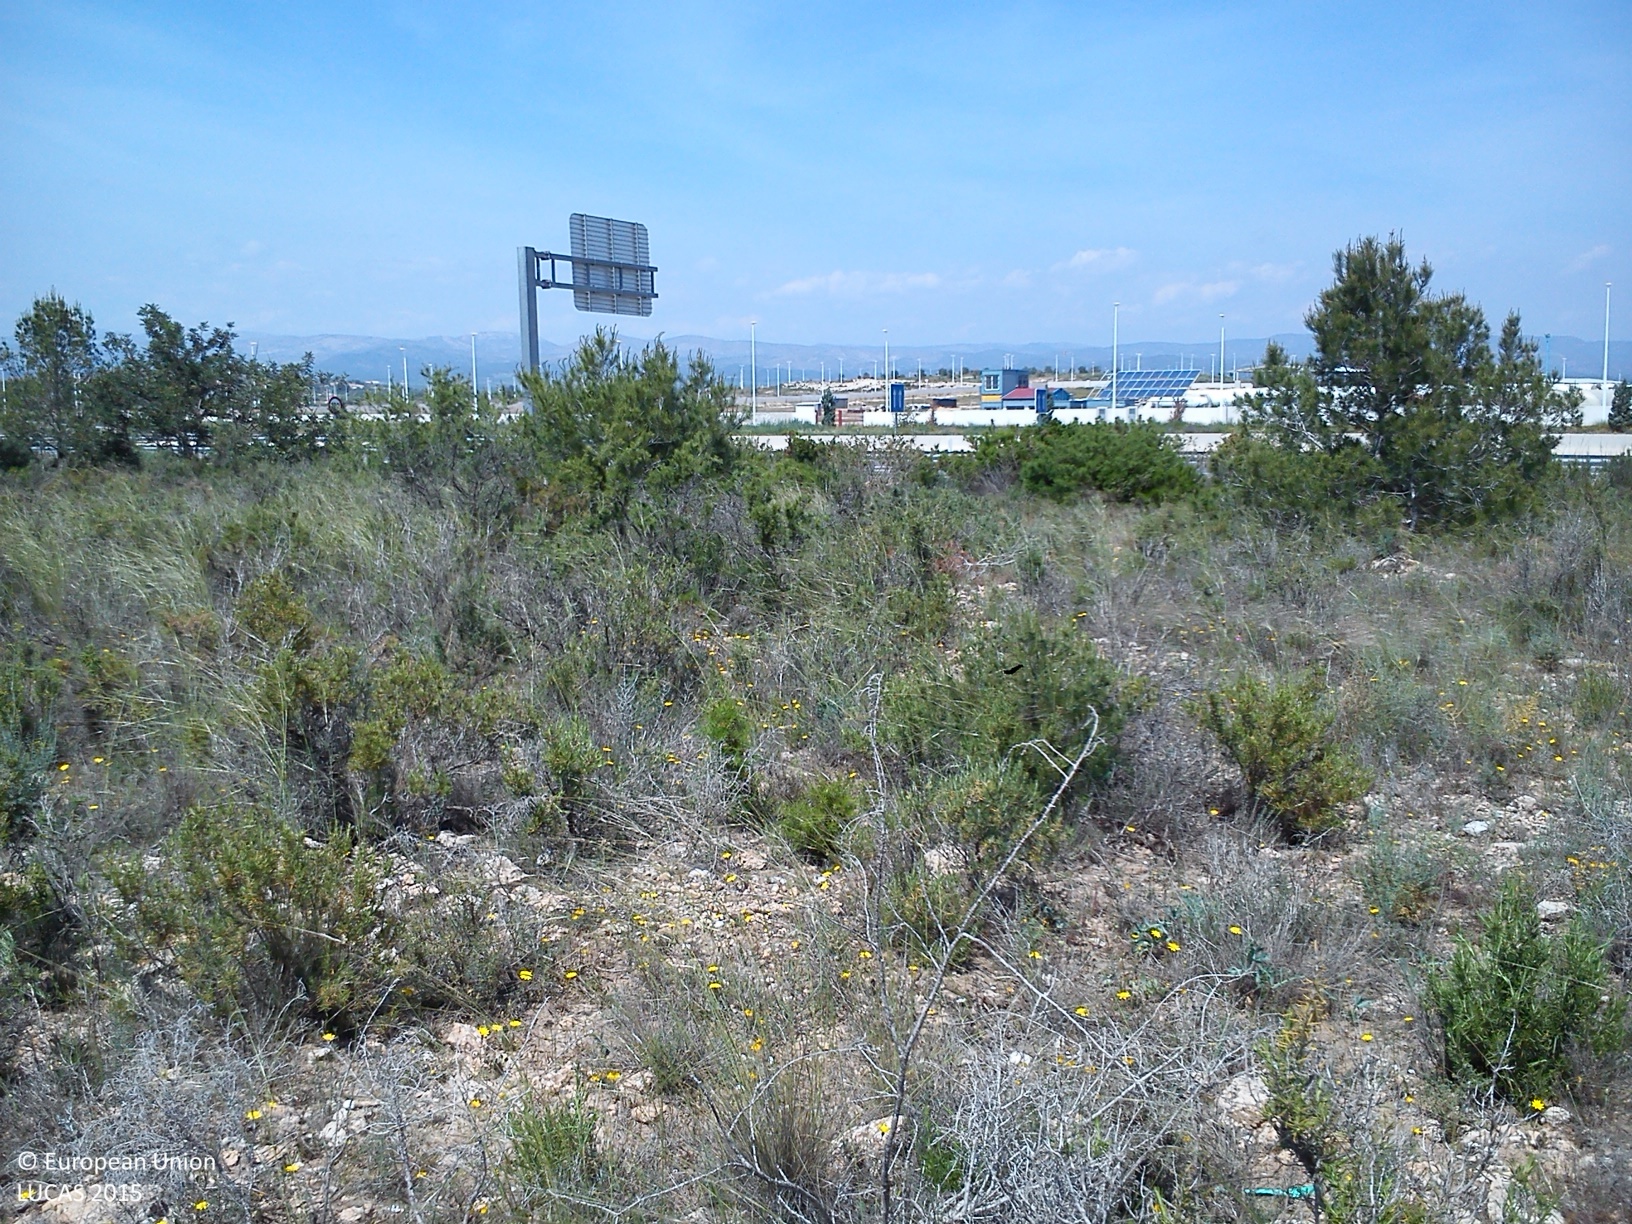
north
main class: Shrubland
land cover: Shrubland with sparse tree cover
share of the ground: > 75 %
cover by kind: shrubs 80 %, herbaceous plants 15 %, coniferous forest trees 5 %
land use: Semi-natural and natural areas not in use
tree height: < 5 m
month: April
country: ES
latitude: 39.6505
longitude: -0.6407
